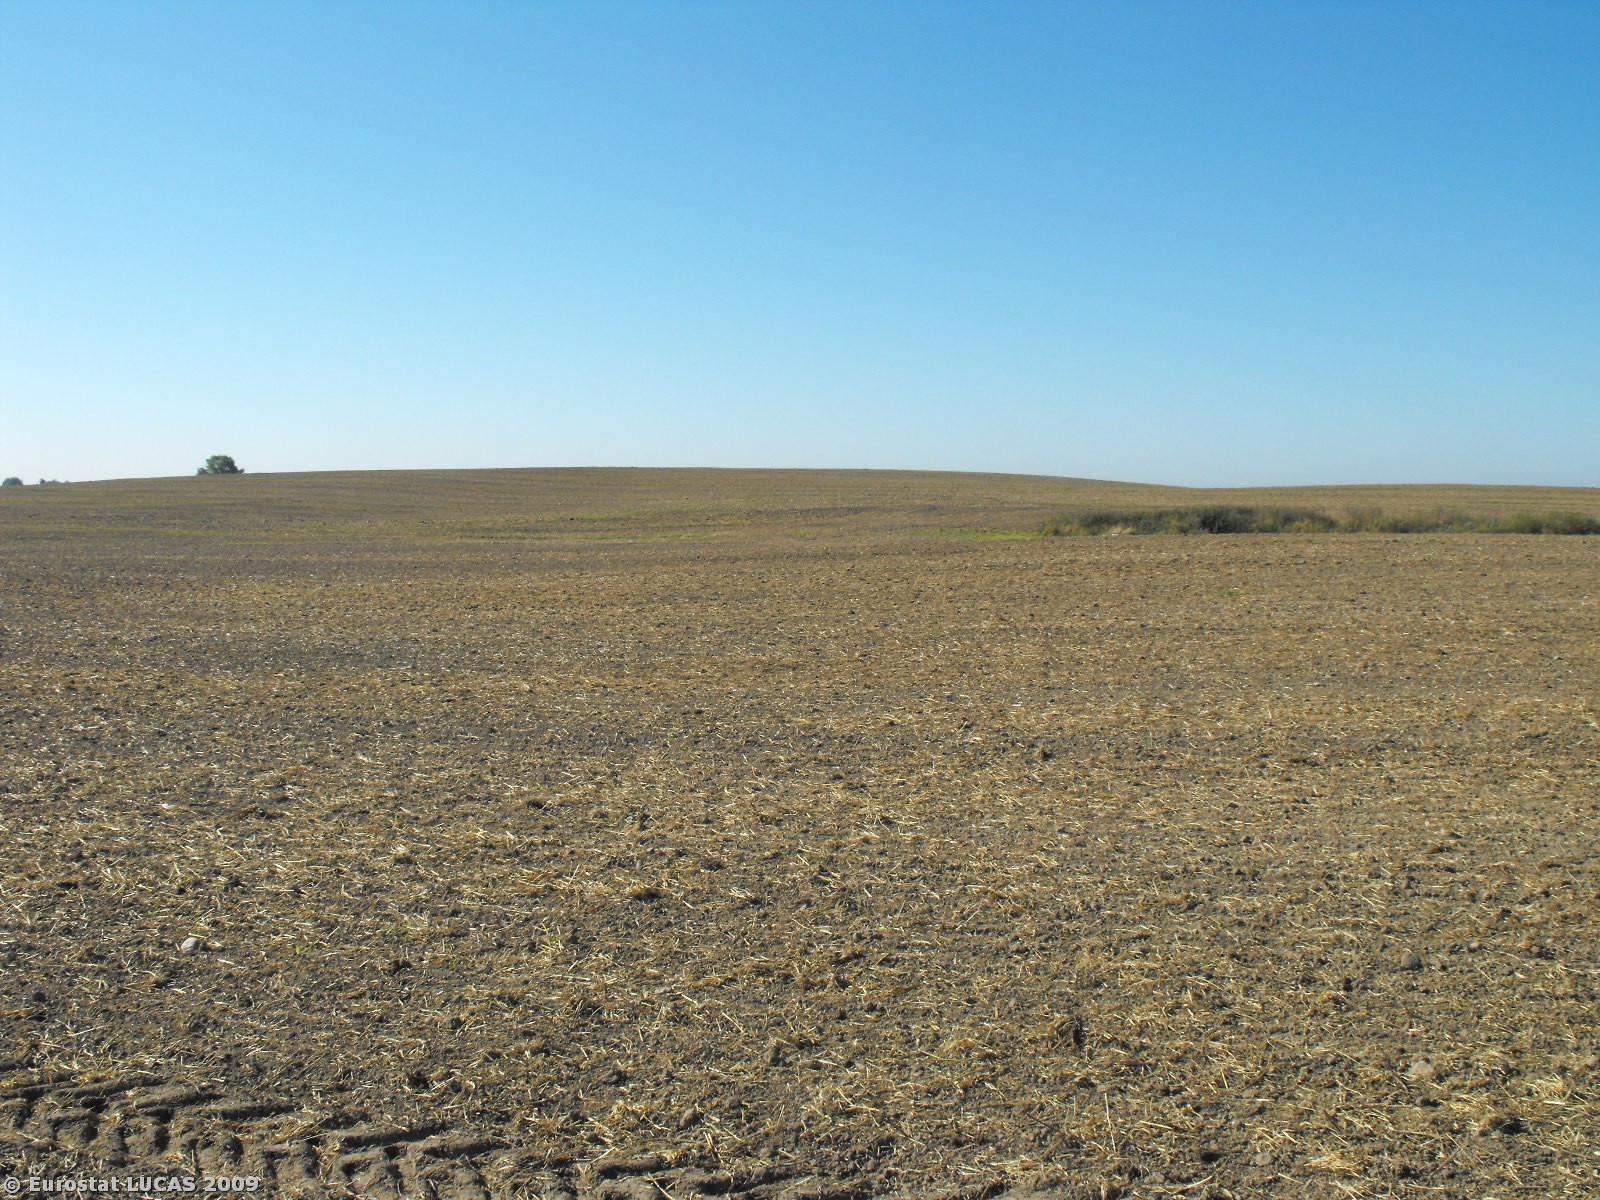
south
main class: Cropland
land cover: Barley
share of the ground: < 10 %
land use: Agriculture (excluding fallow land and kitchen gardens)
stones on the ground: < 10 %
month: September
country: PL
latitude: 53.1708
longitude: 16.5447
